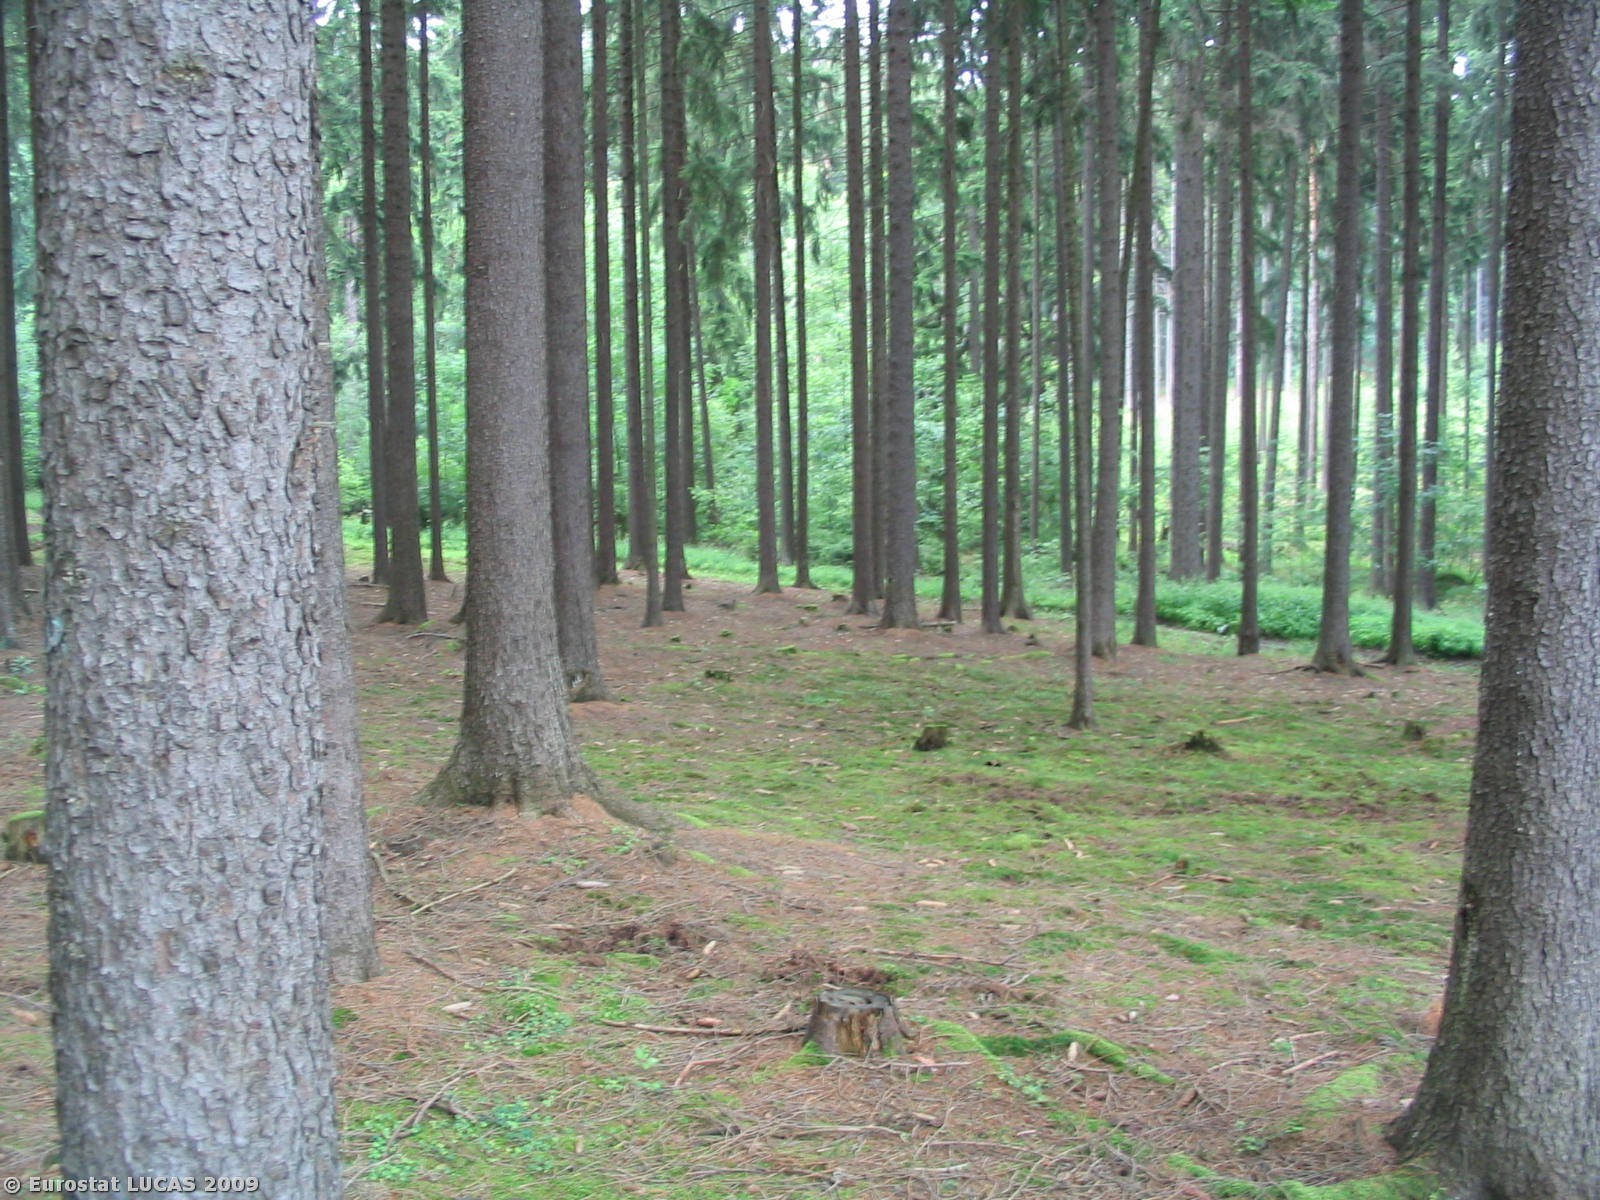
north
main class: Woodland
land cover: Coniferous woodland
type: hemiboreal forest and nemoral coniferous forest and mixed broadleaved-coniferous forest
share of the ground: > 75 %
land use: Forestry
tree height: > 5 m
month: July
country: CZ
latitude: 49.4051
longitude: 16.4704
